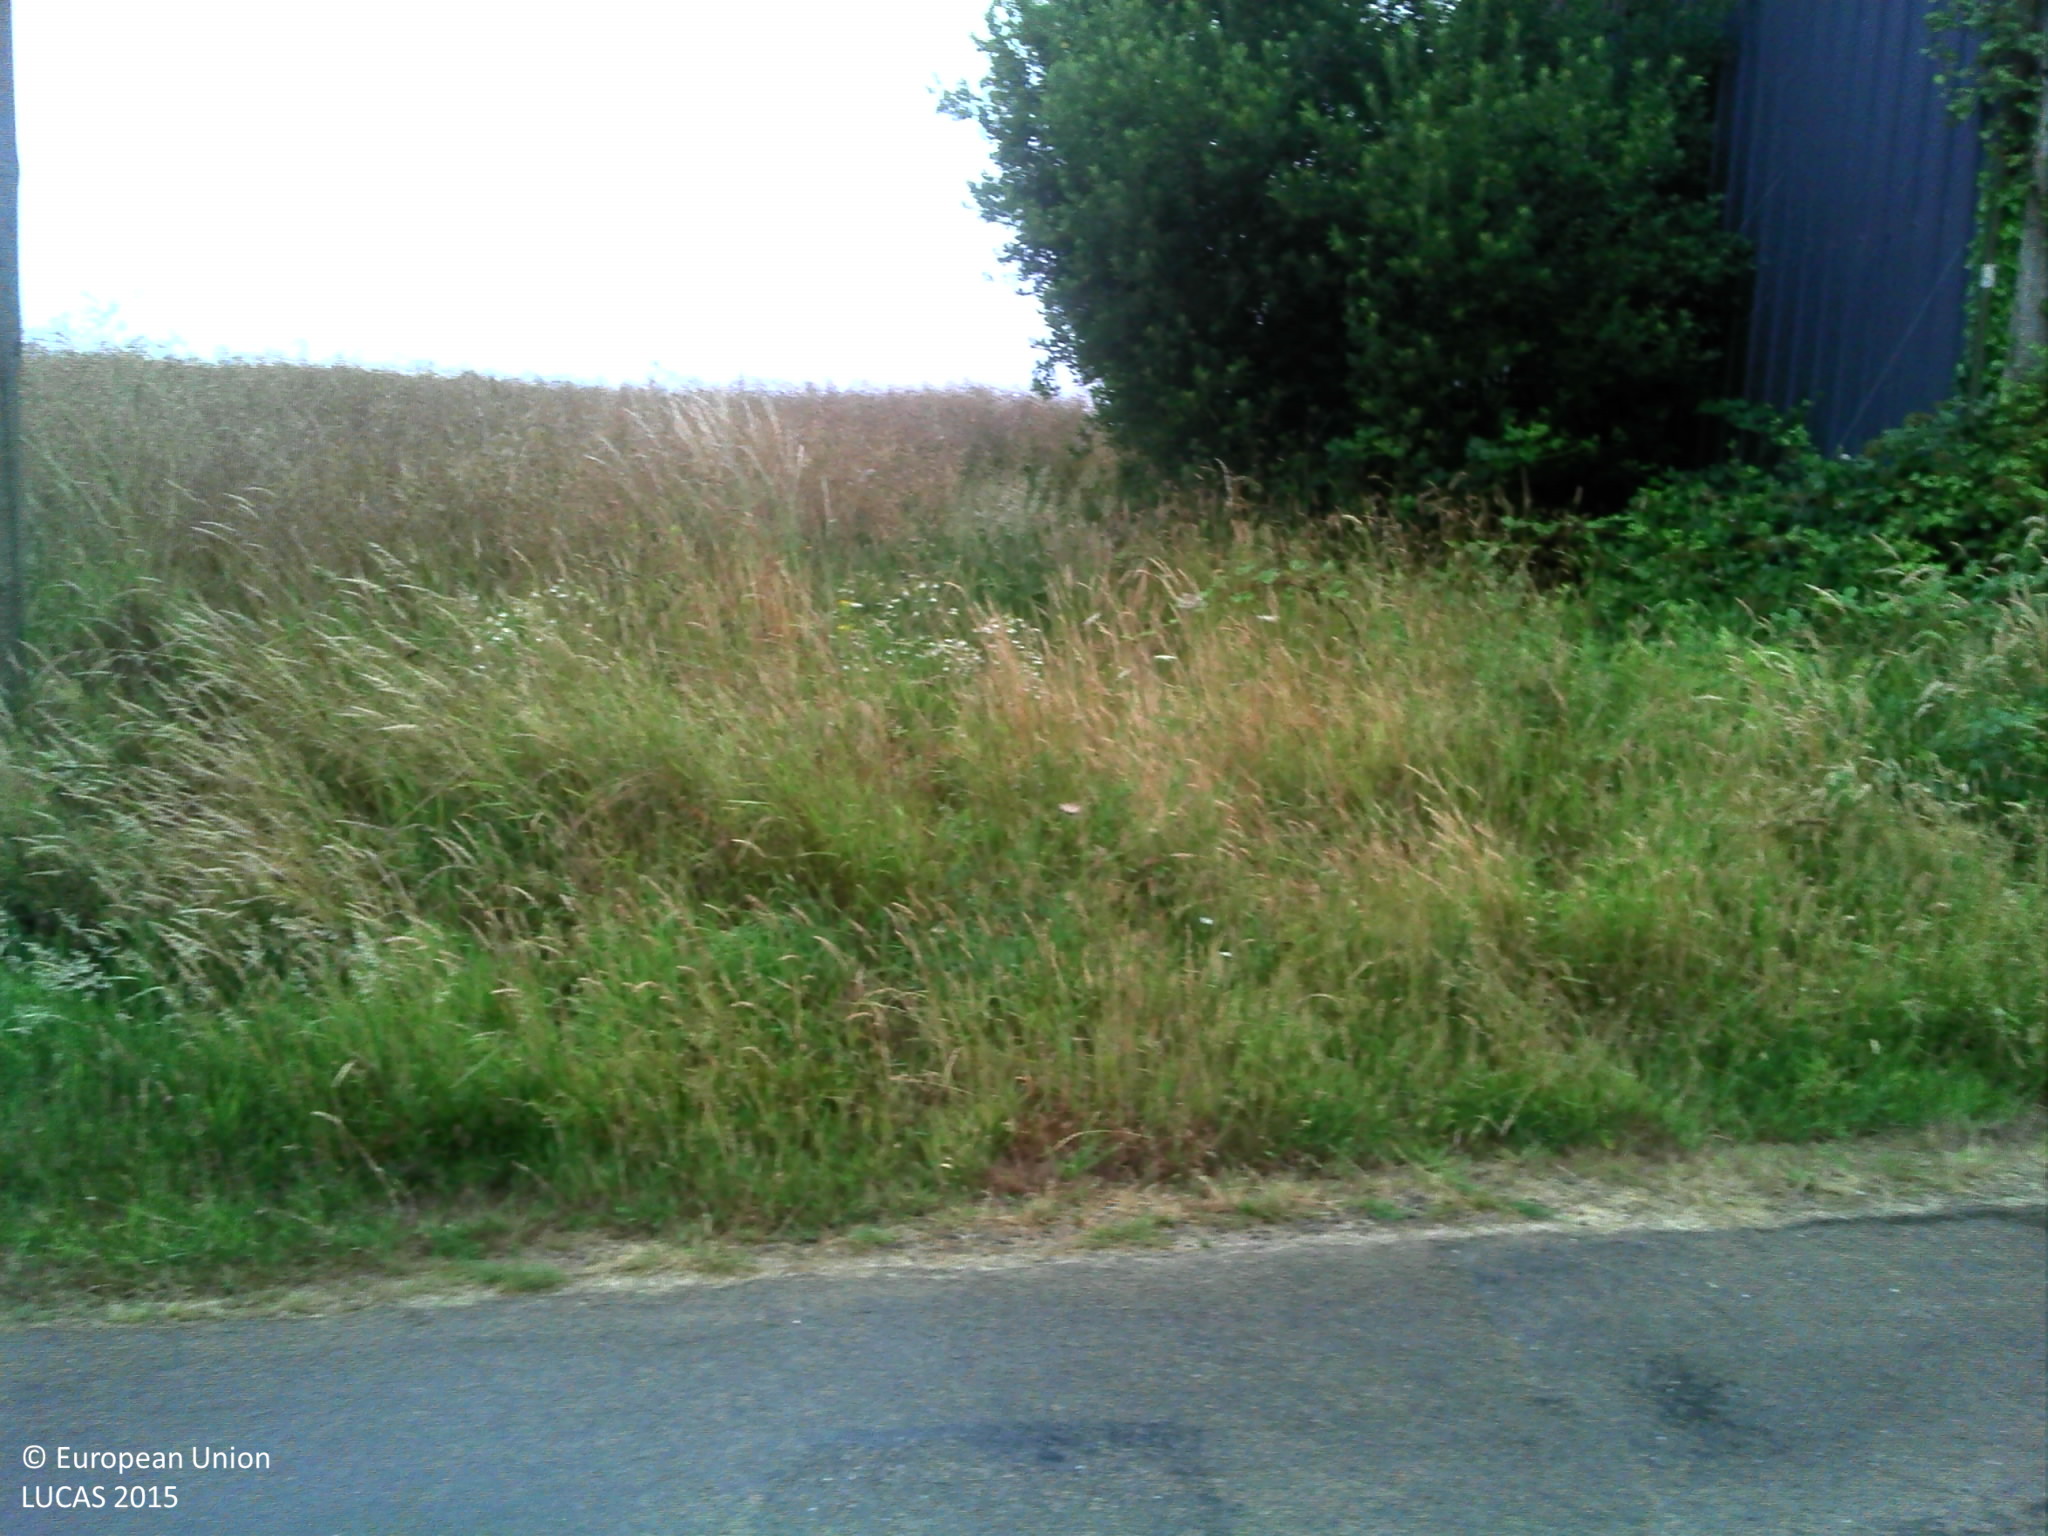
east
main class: Grassland
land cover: Grassland without tree/shrub cover
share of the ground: > 75 %
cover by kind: herbaceous plants 100 %
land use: Agriculture (excluding fallow land and kitchen gardens)
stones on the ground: 10 - 25 %
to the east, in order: Grassland without tree/shrub cover; Paved roads, cycling and walking lanes; Grass margins; Electric lines; Ditches and canals; Grass margins; Rape and turnip rape
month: July
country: FR
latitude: 48.2623
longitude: -1.9472
